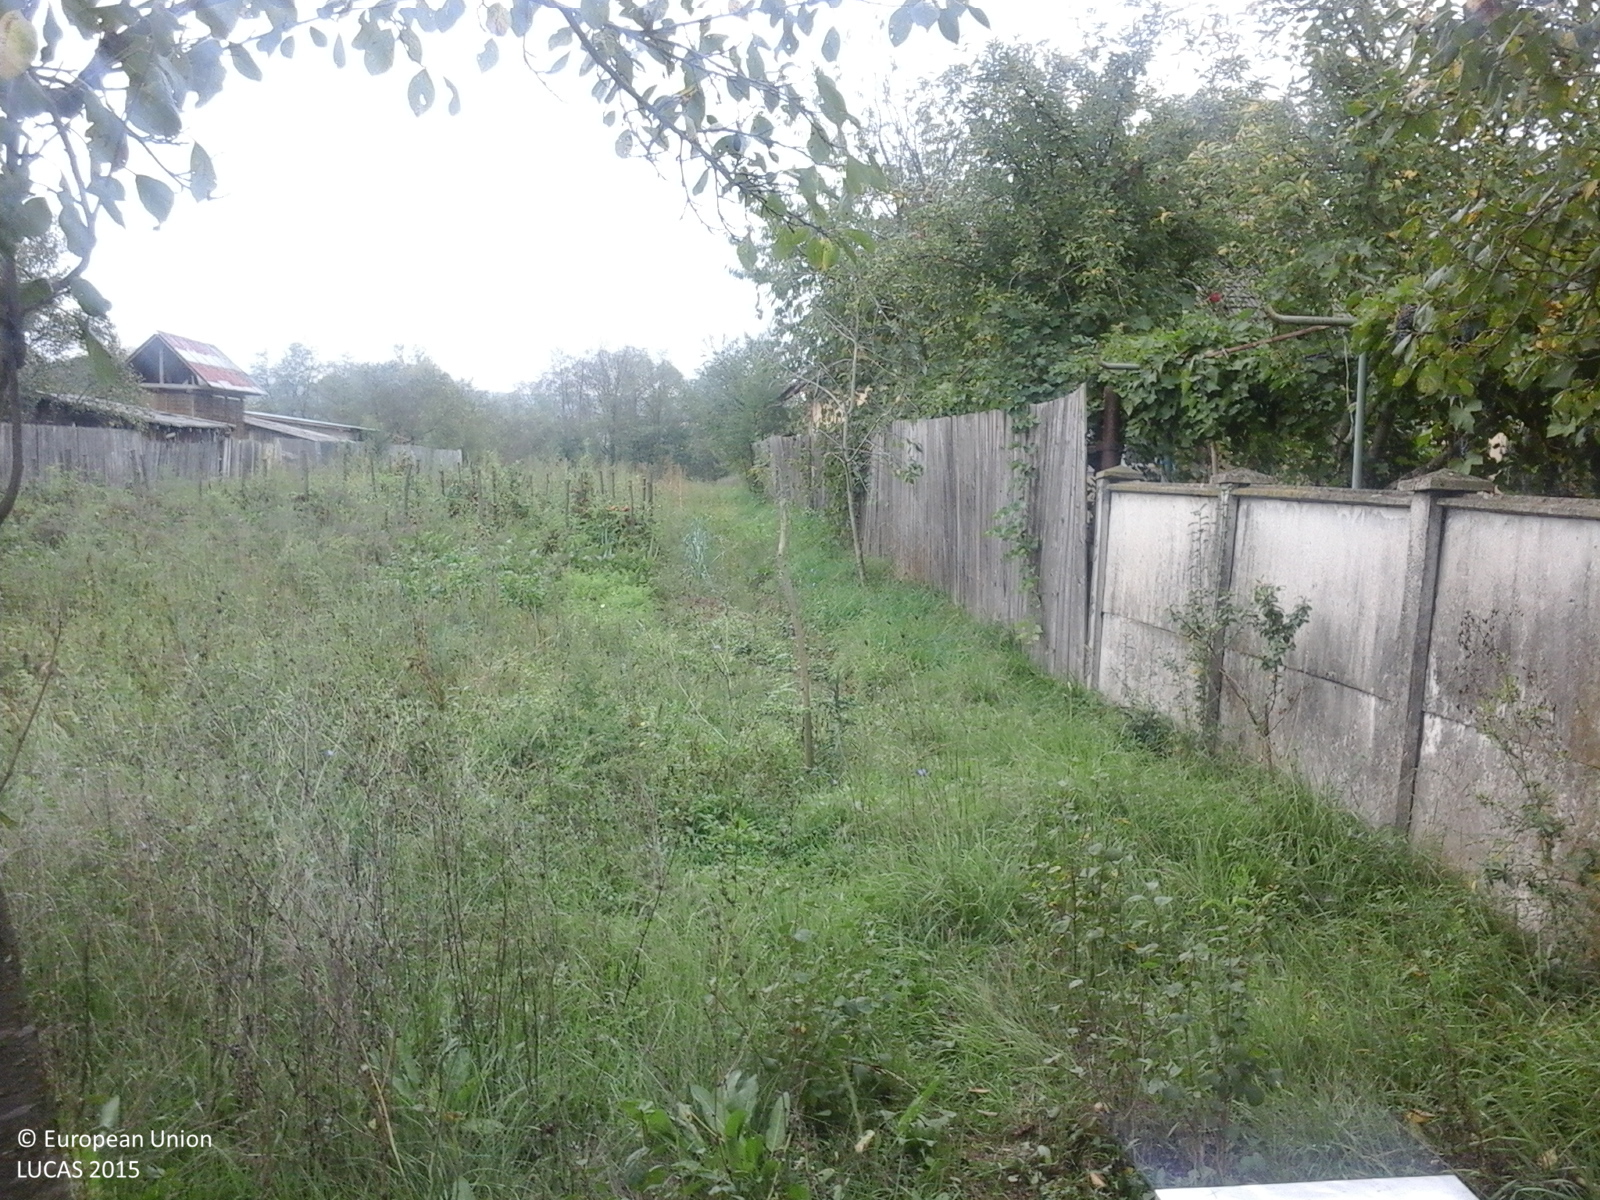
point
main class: Cropland
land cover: Tomatoes
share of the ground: > 75 %
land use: Kitchen garden
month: September
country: RO
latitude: 44.9829
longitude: 23.3326
